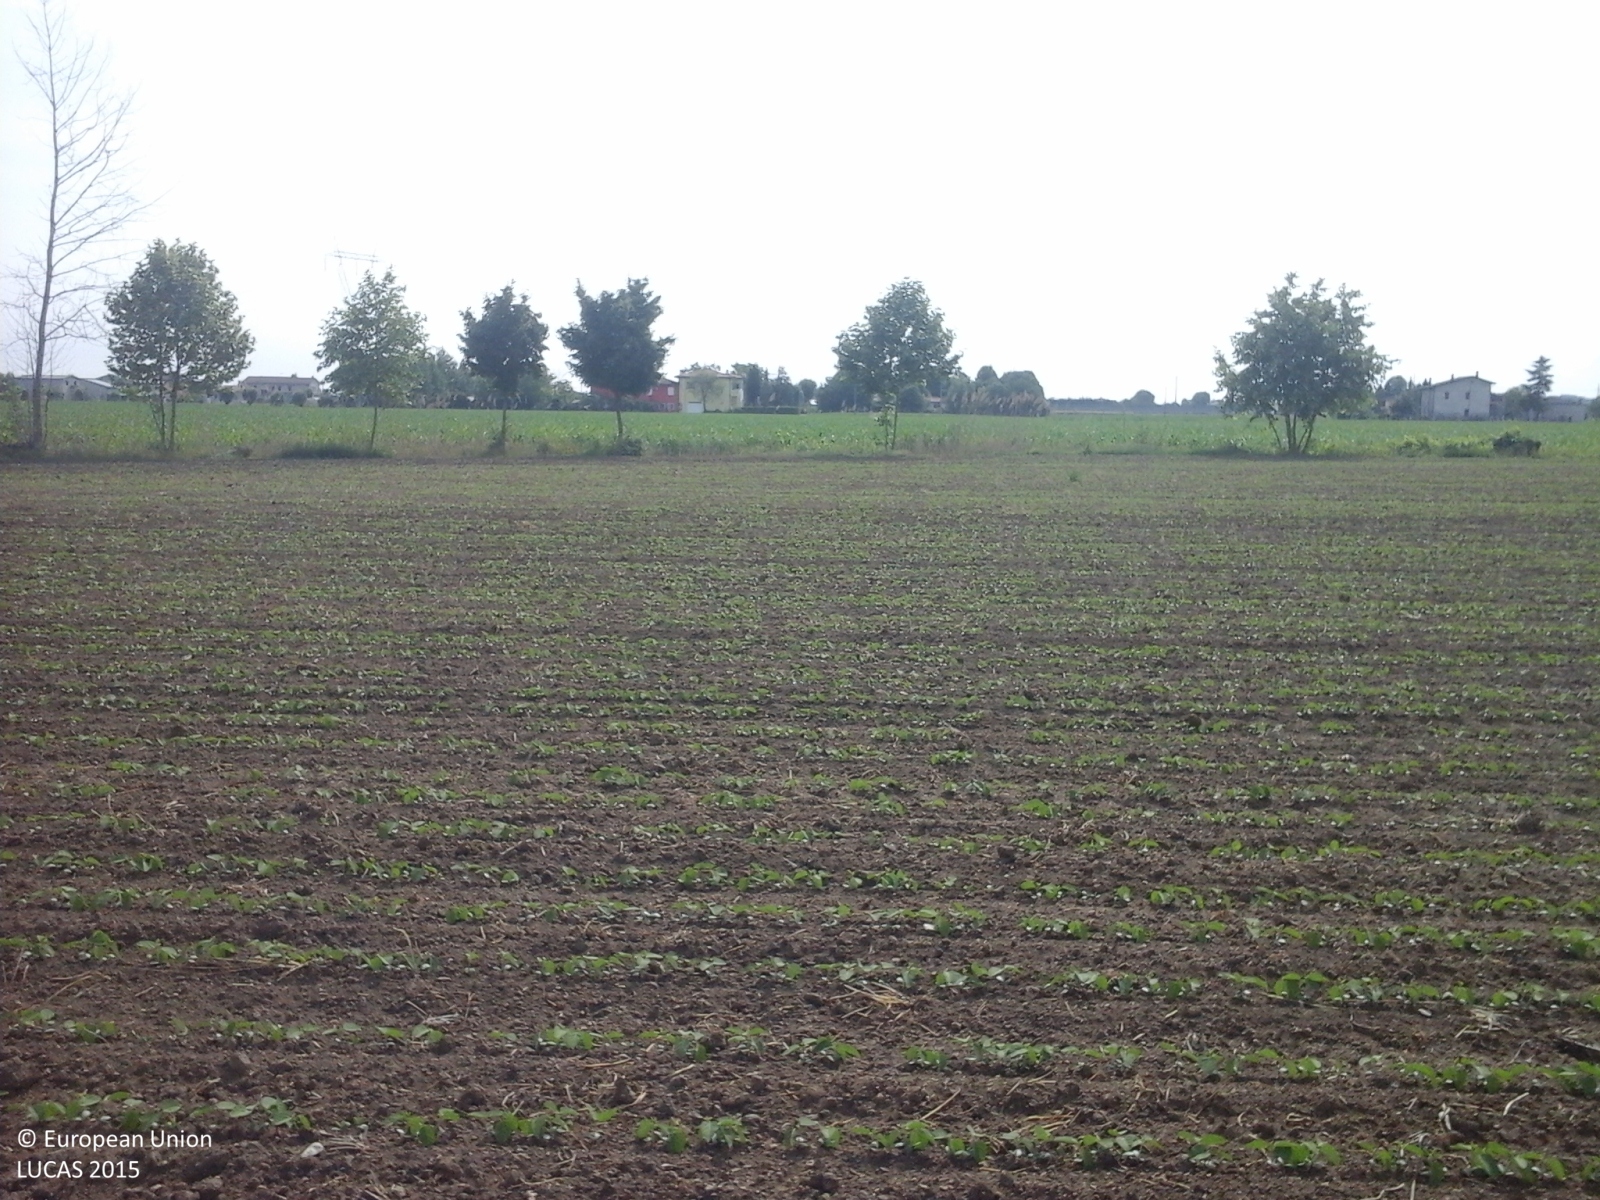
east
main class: Cropland
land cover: Soya
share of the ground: < 10 %
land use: Agriculture (excluding fallow land and kitchen gardens)
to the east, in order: Soya; Grass margins; Managed hedges; Ditches and canals; Grass margins; Maize; Ditches and canals; Maize; Ditches and canals; Maize; Grass margins; Ditches and canals; Grass margins; Lucerne; Electric lines; Lucerne
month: May
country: IT
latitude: 45.4019
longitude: 11.6198
